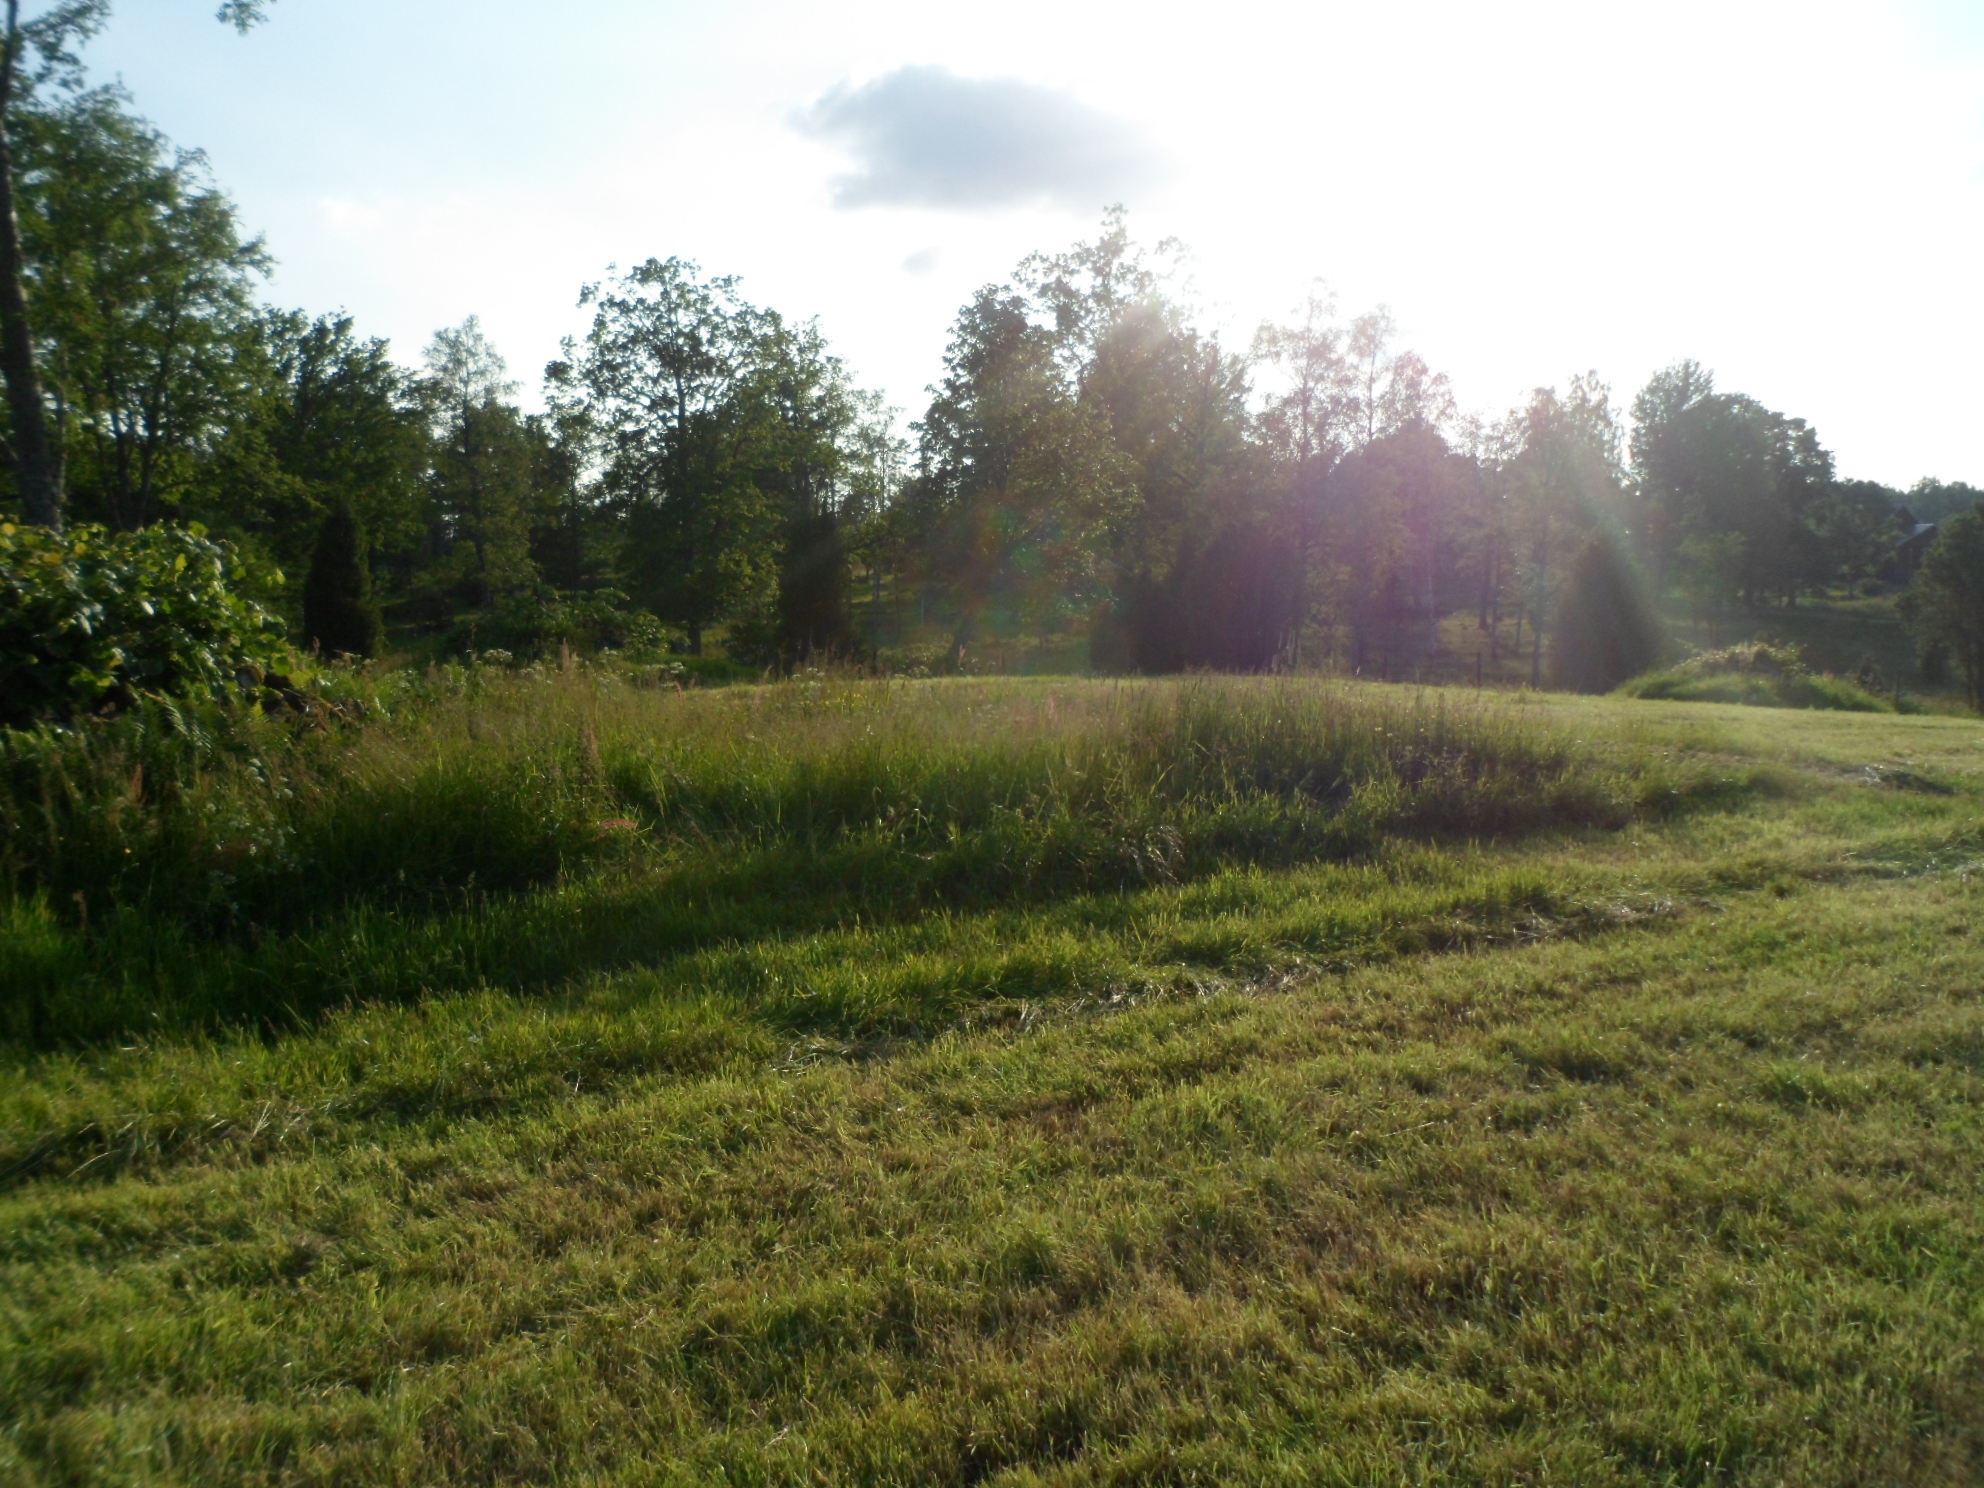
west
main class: Grassland
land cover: Grassland without tree/shrub cover
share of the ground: > 75 %
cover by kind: herbaceous plants 100 %
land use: Agriculture (excluding fallow land and kitchen gardens)
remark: Harvested field
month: June
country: SE
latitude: 57.0824
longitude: 15.4259
